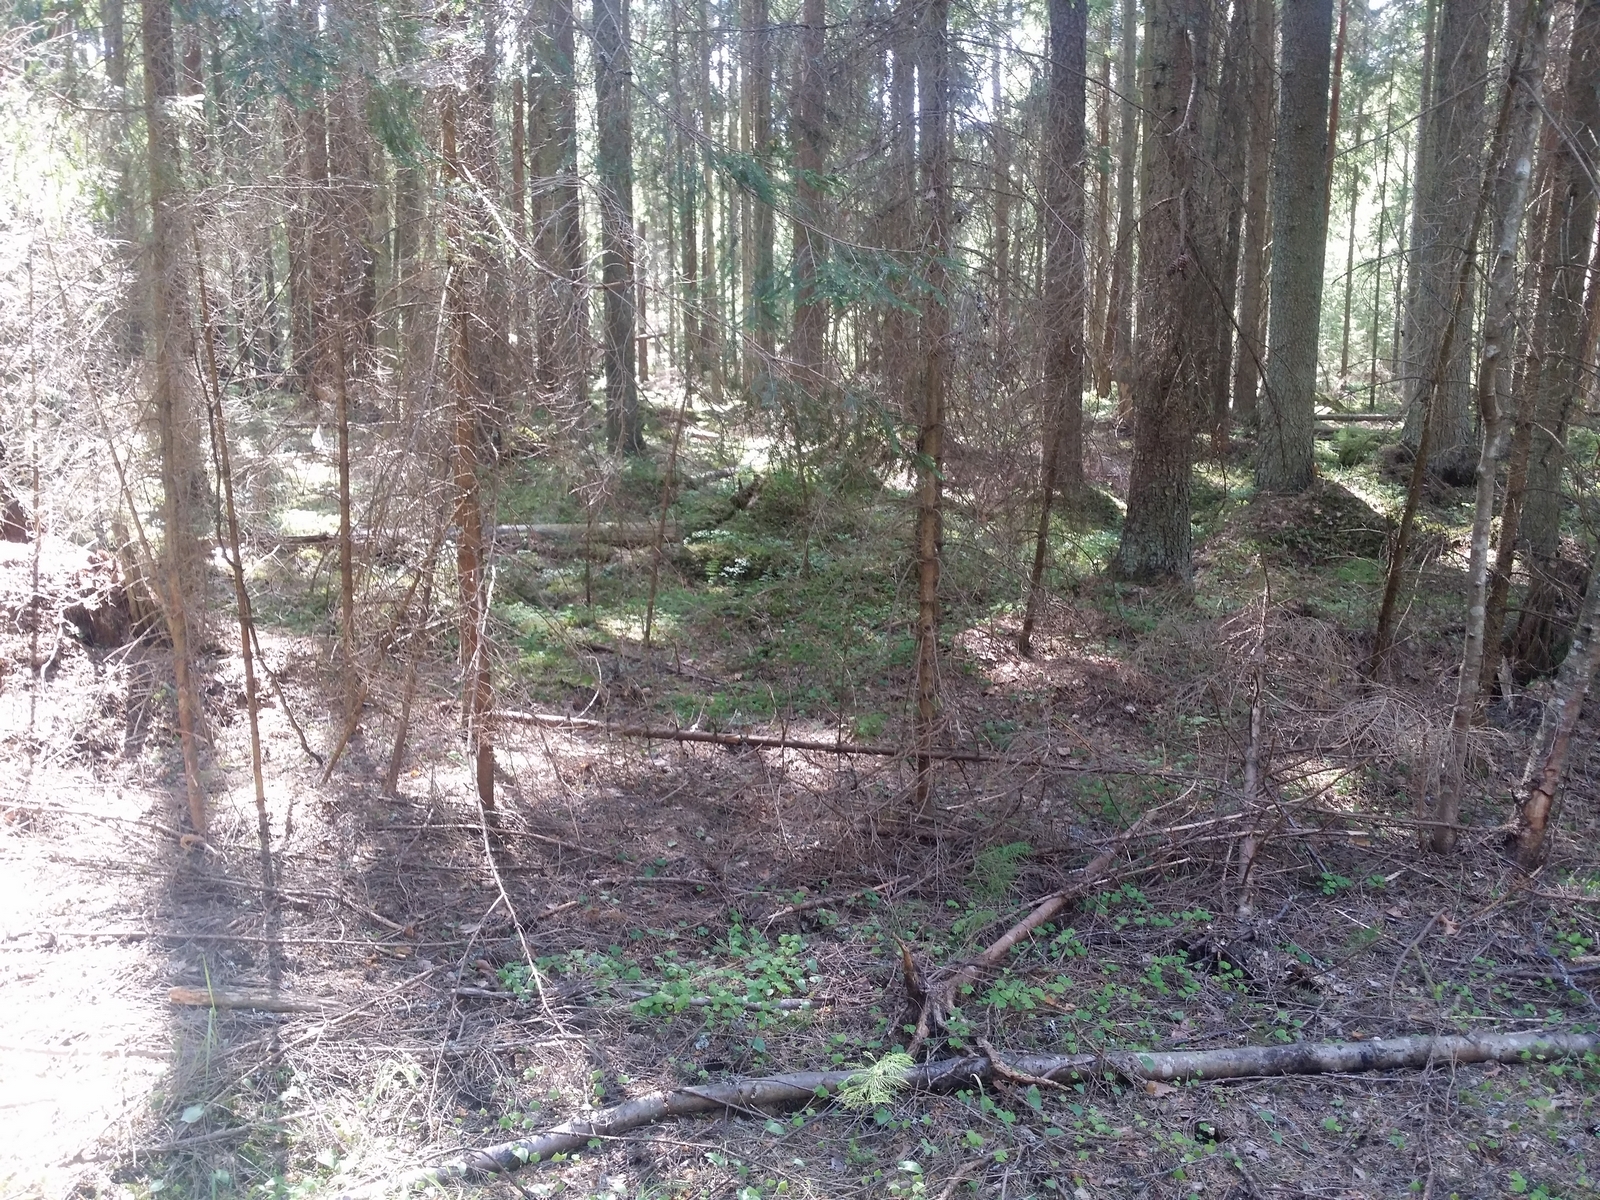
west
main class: Woodland
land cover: Spruce dominated coniferous woodland
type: hemiboreal forest and nemoral coniferous forest and mixed broadleaved-coniferous forest
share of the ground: > 75 %
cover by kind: coniferous forest trees 75 %, lichens and mosses 15 %, herbaceous plants 10 %
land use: Forestry
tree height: > 5 m
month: June
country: LV
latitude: 57.3258
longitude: 26.4343
